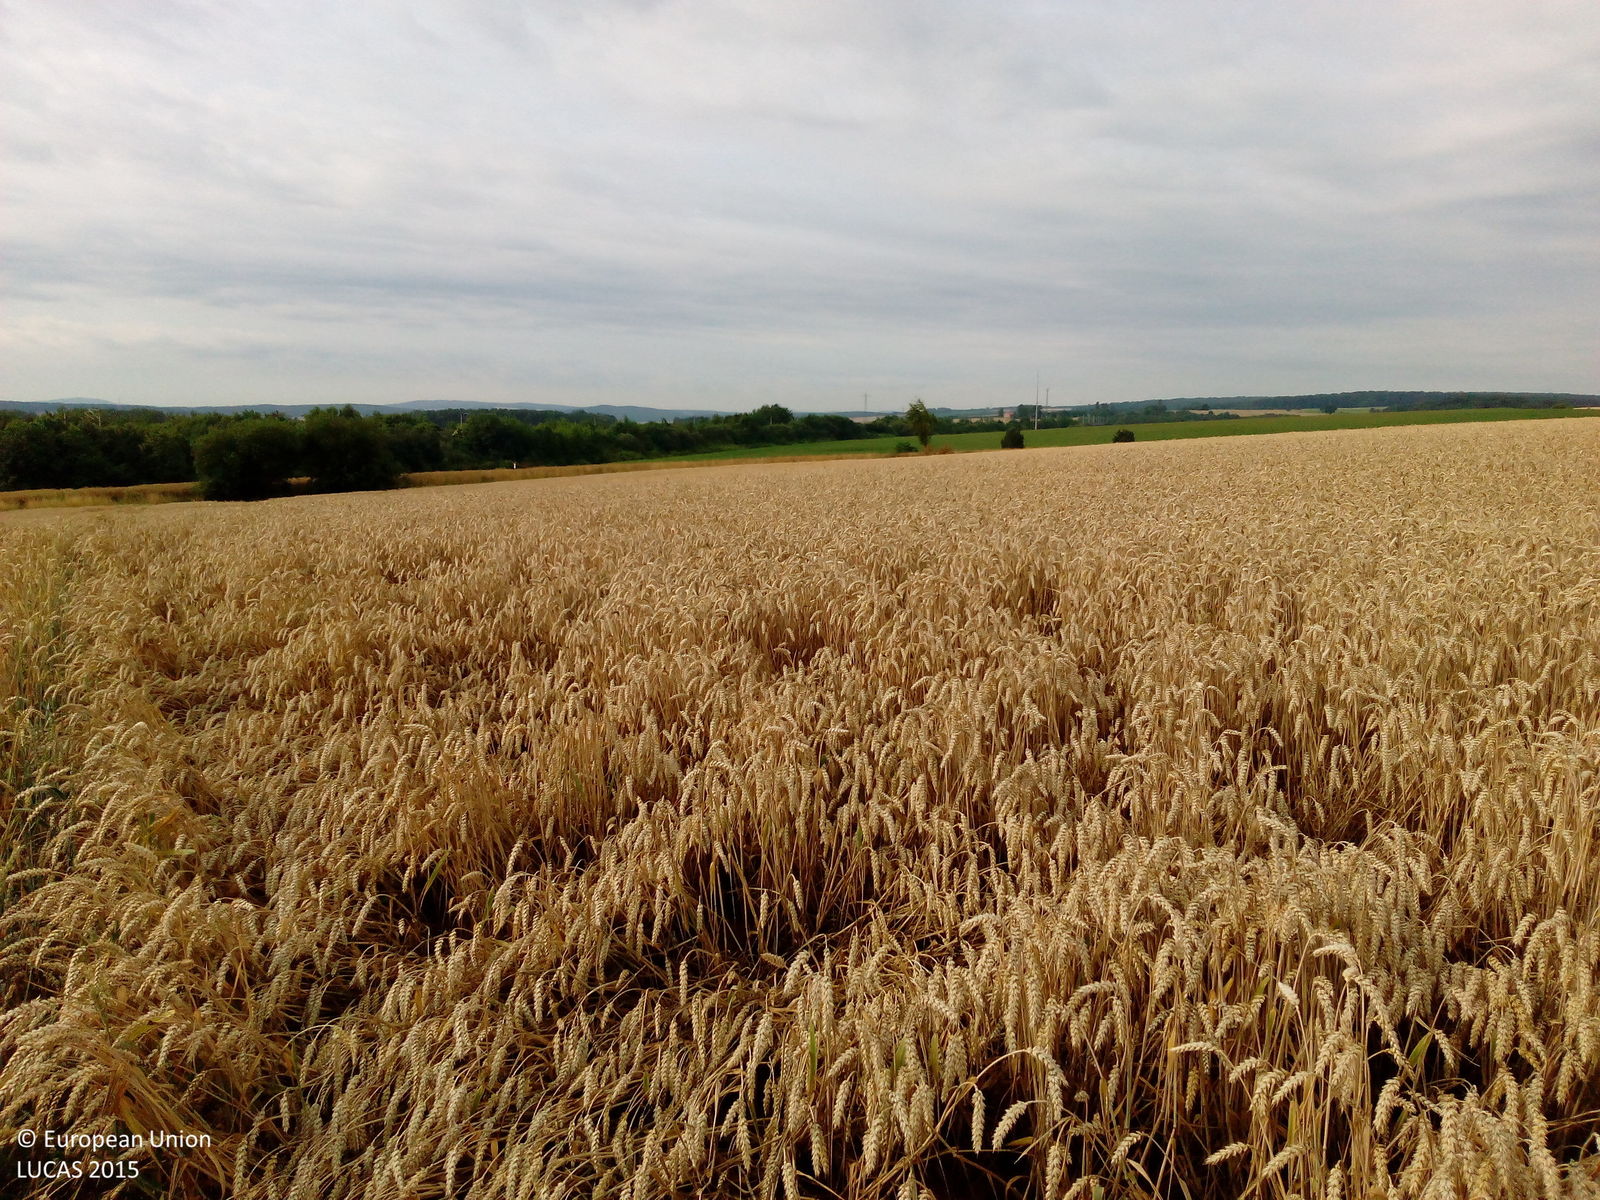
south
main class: Cropland
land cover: Common wheat
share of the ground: > 75 %
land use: Agriculture (excluding fallow land and kitchen gardens)
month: July
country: DE
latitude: 51.5146
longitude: 9.8704
